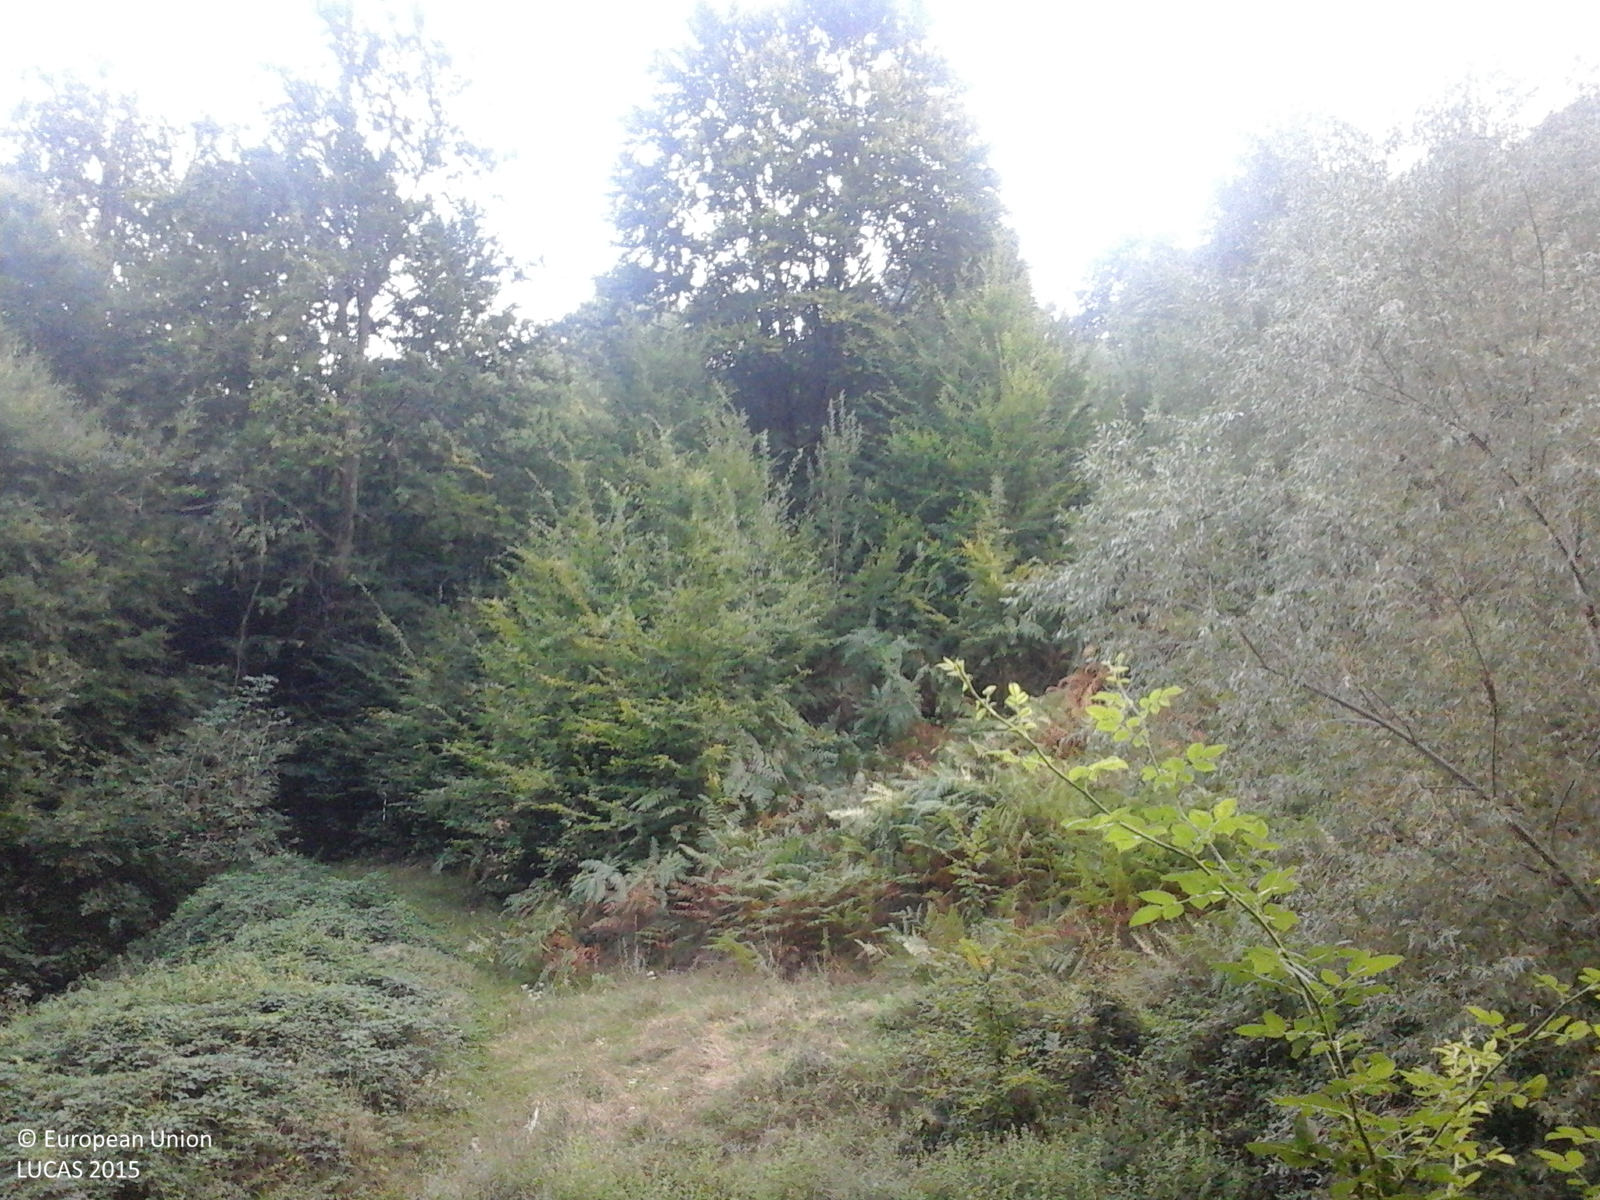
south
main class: Grassland
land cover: Spontaneously vegetated surfaces
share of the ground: > 75 %
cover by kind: herbaceous plants 100 %
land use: Forestry
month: August
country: RO
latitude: 46.4636
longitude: 22.2488
